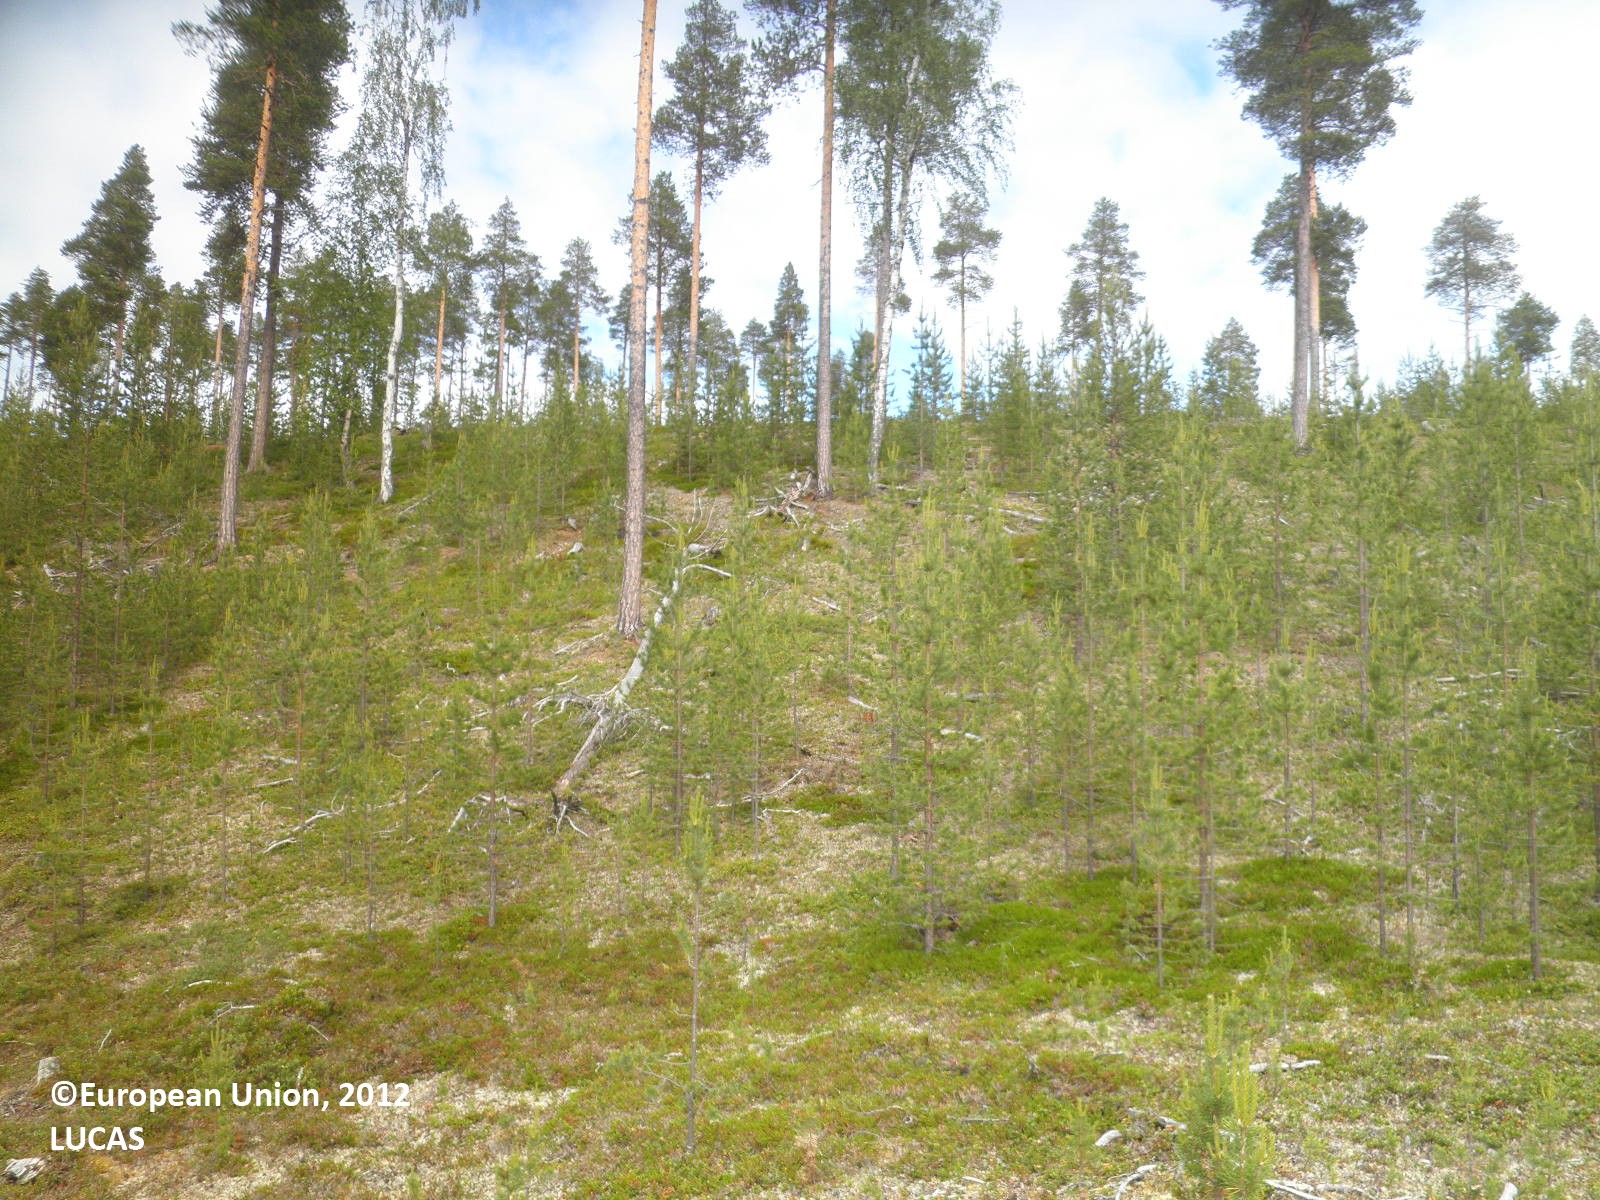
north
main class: Woodland
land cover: Pine dominated coniferous woodland
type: boreal forest
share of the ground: 25 - 50 %
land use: Forestry
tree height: > 5 m
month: July
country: FI
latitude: 68.6977
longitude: 27.8706
